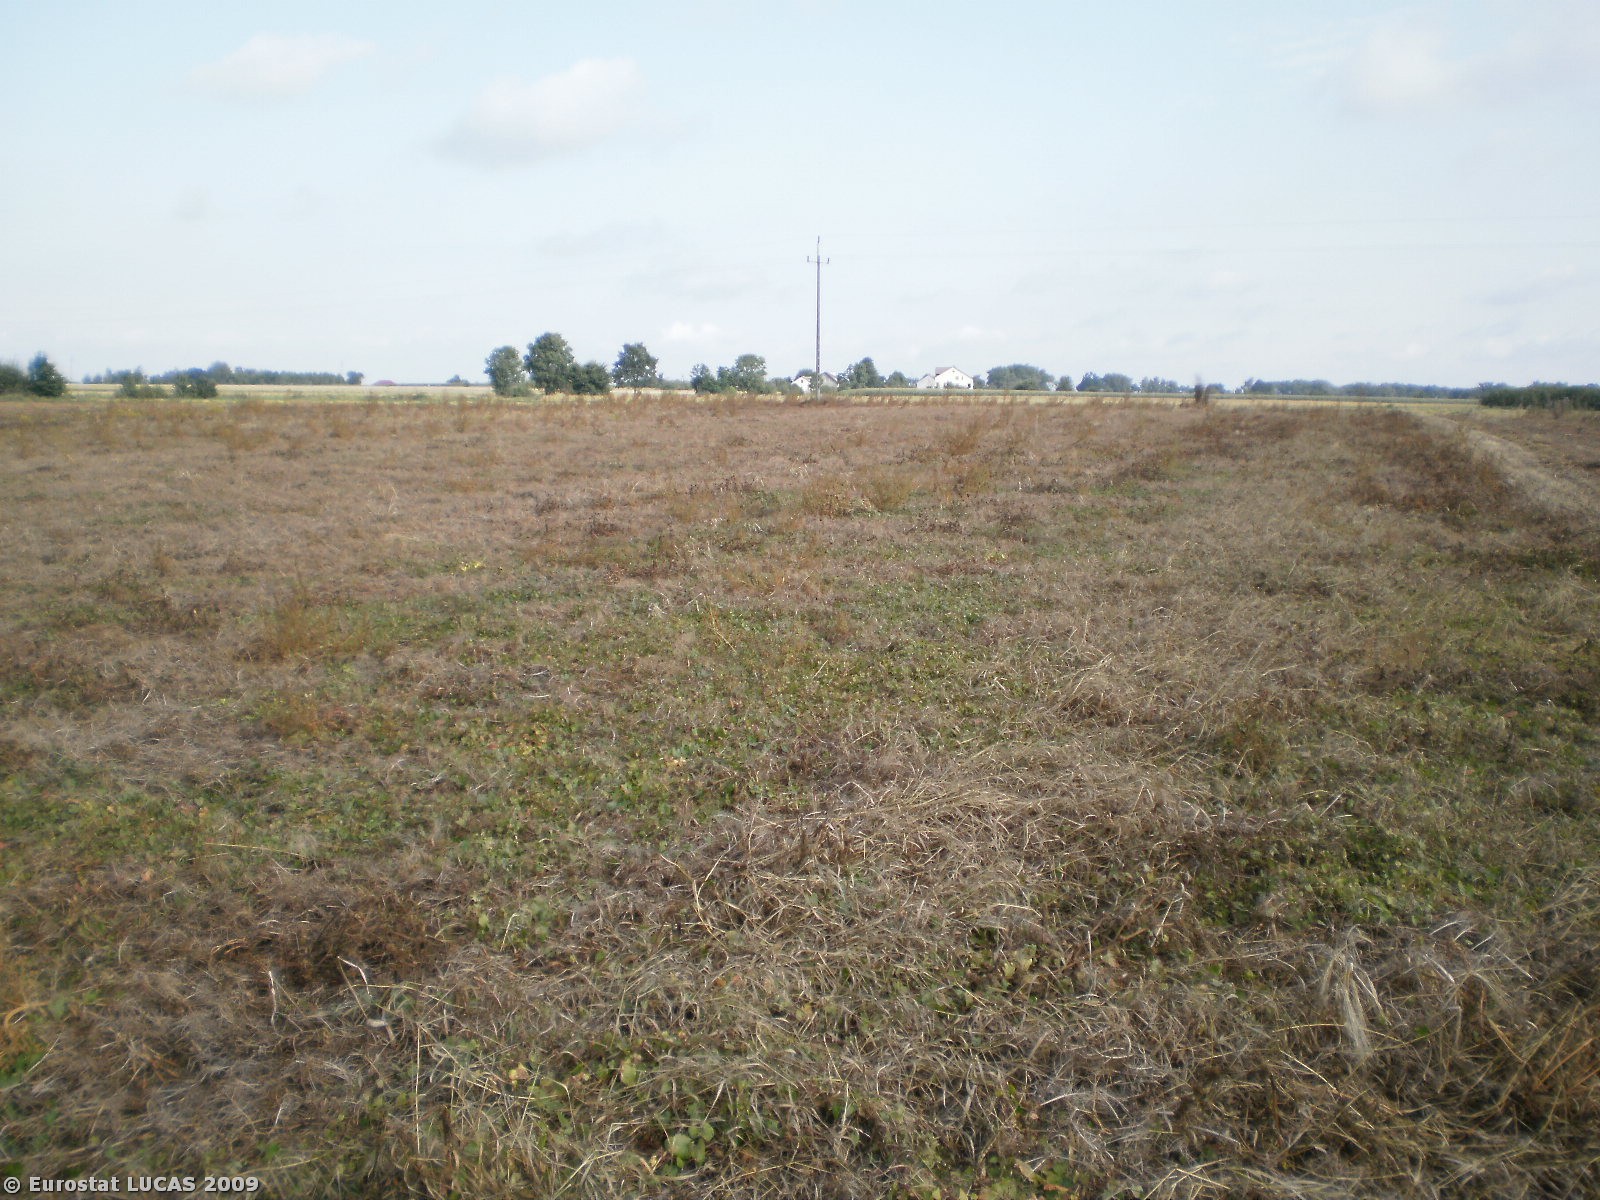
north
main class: Cropland
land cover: Dry pulses
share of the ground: > 75 %
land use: Agriculture (excluding fallow land and kitchen gardens)
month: August
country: PL
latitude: 52.9346
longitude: 21.0092
